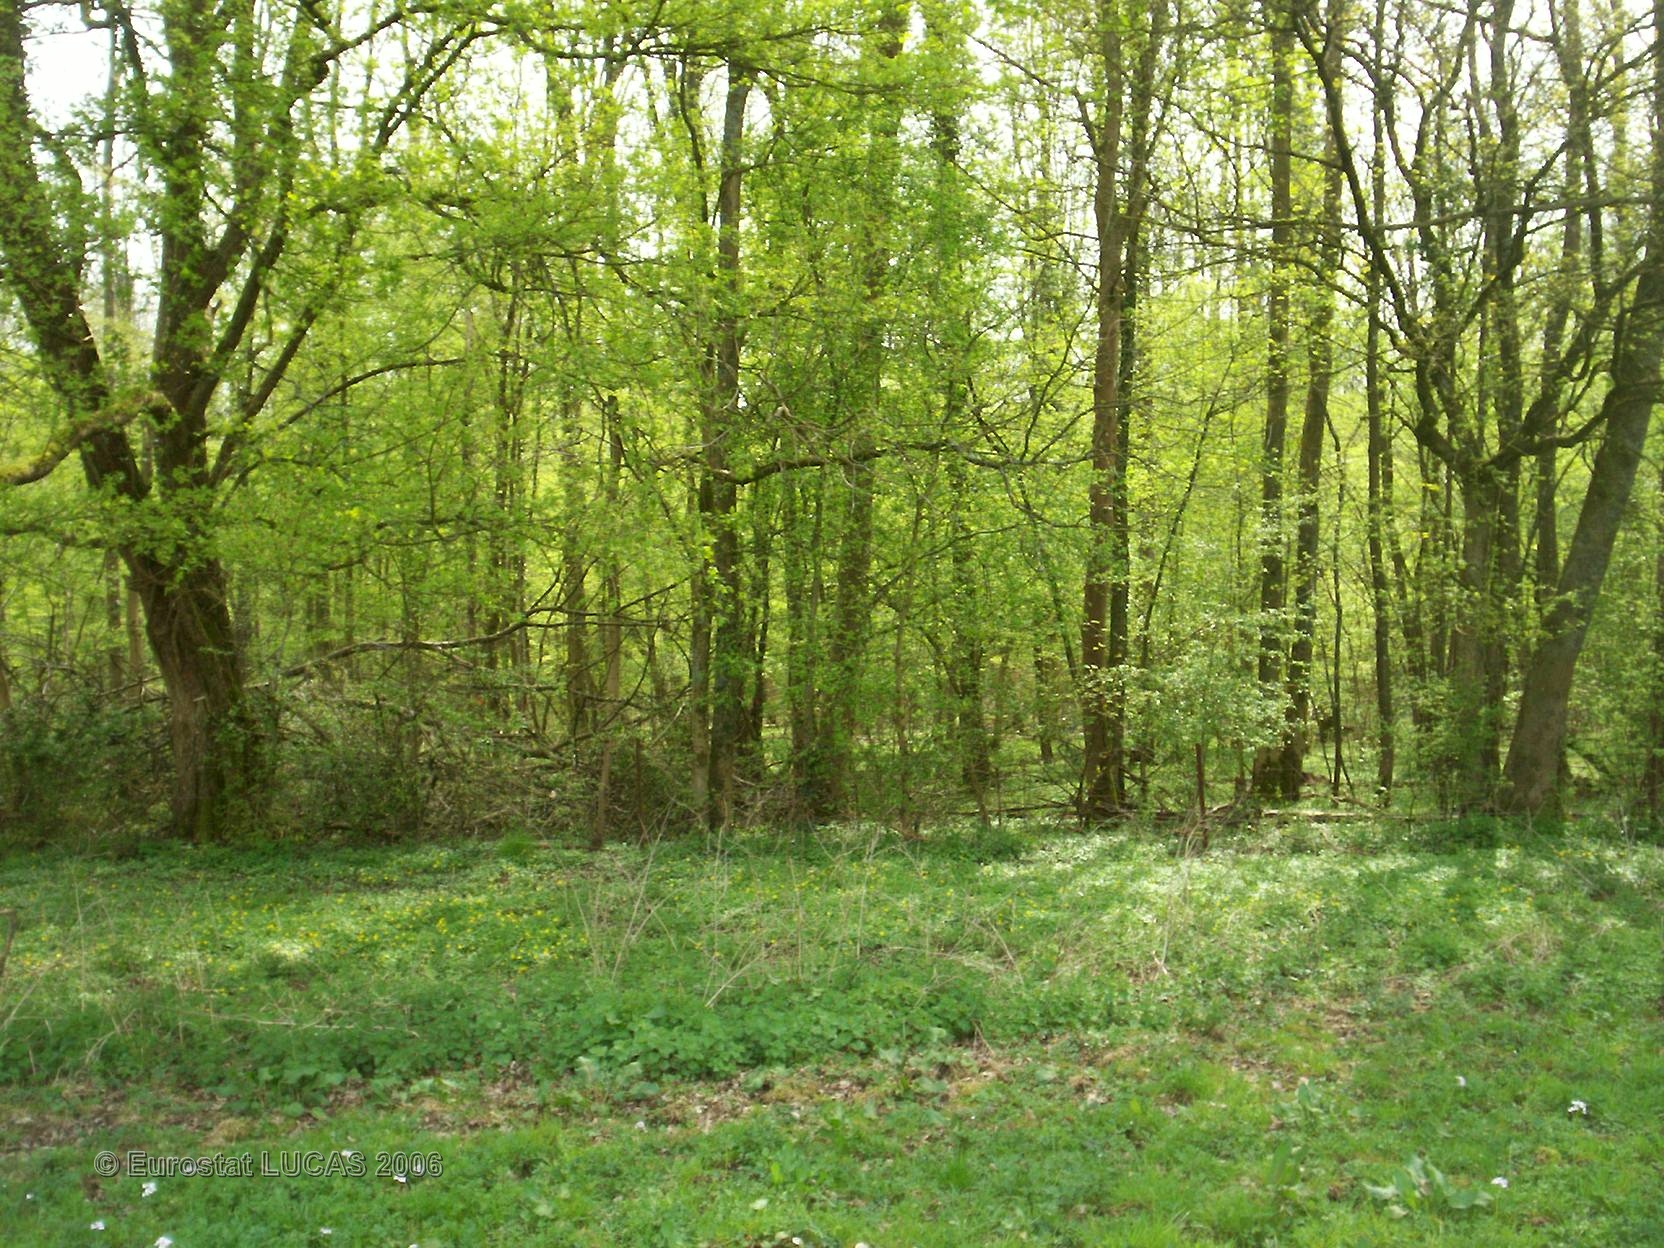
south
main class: Grassland
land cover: Grassland without tree/shrub cover
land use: Agriculture (excluding fallow land and kitchen gardens)
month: May
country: FR
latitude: 49.8824
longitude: 4.3592
